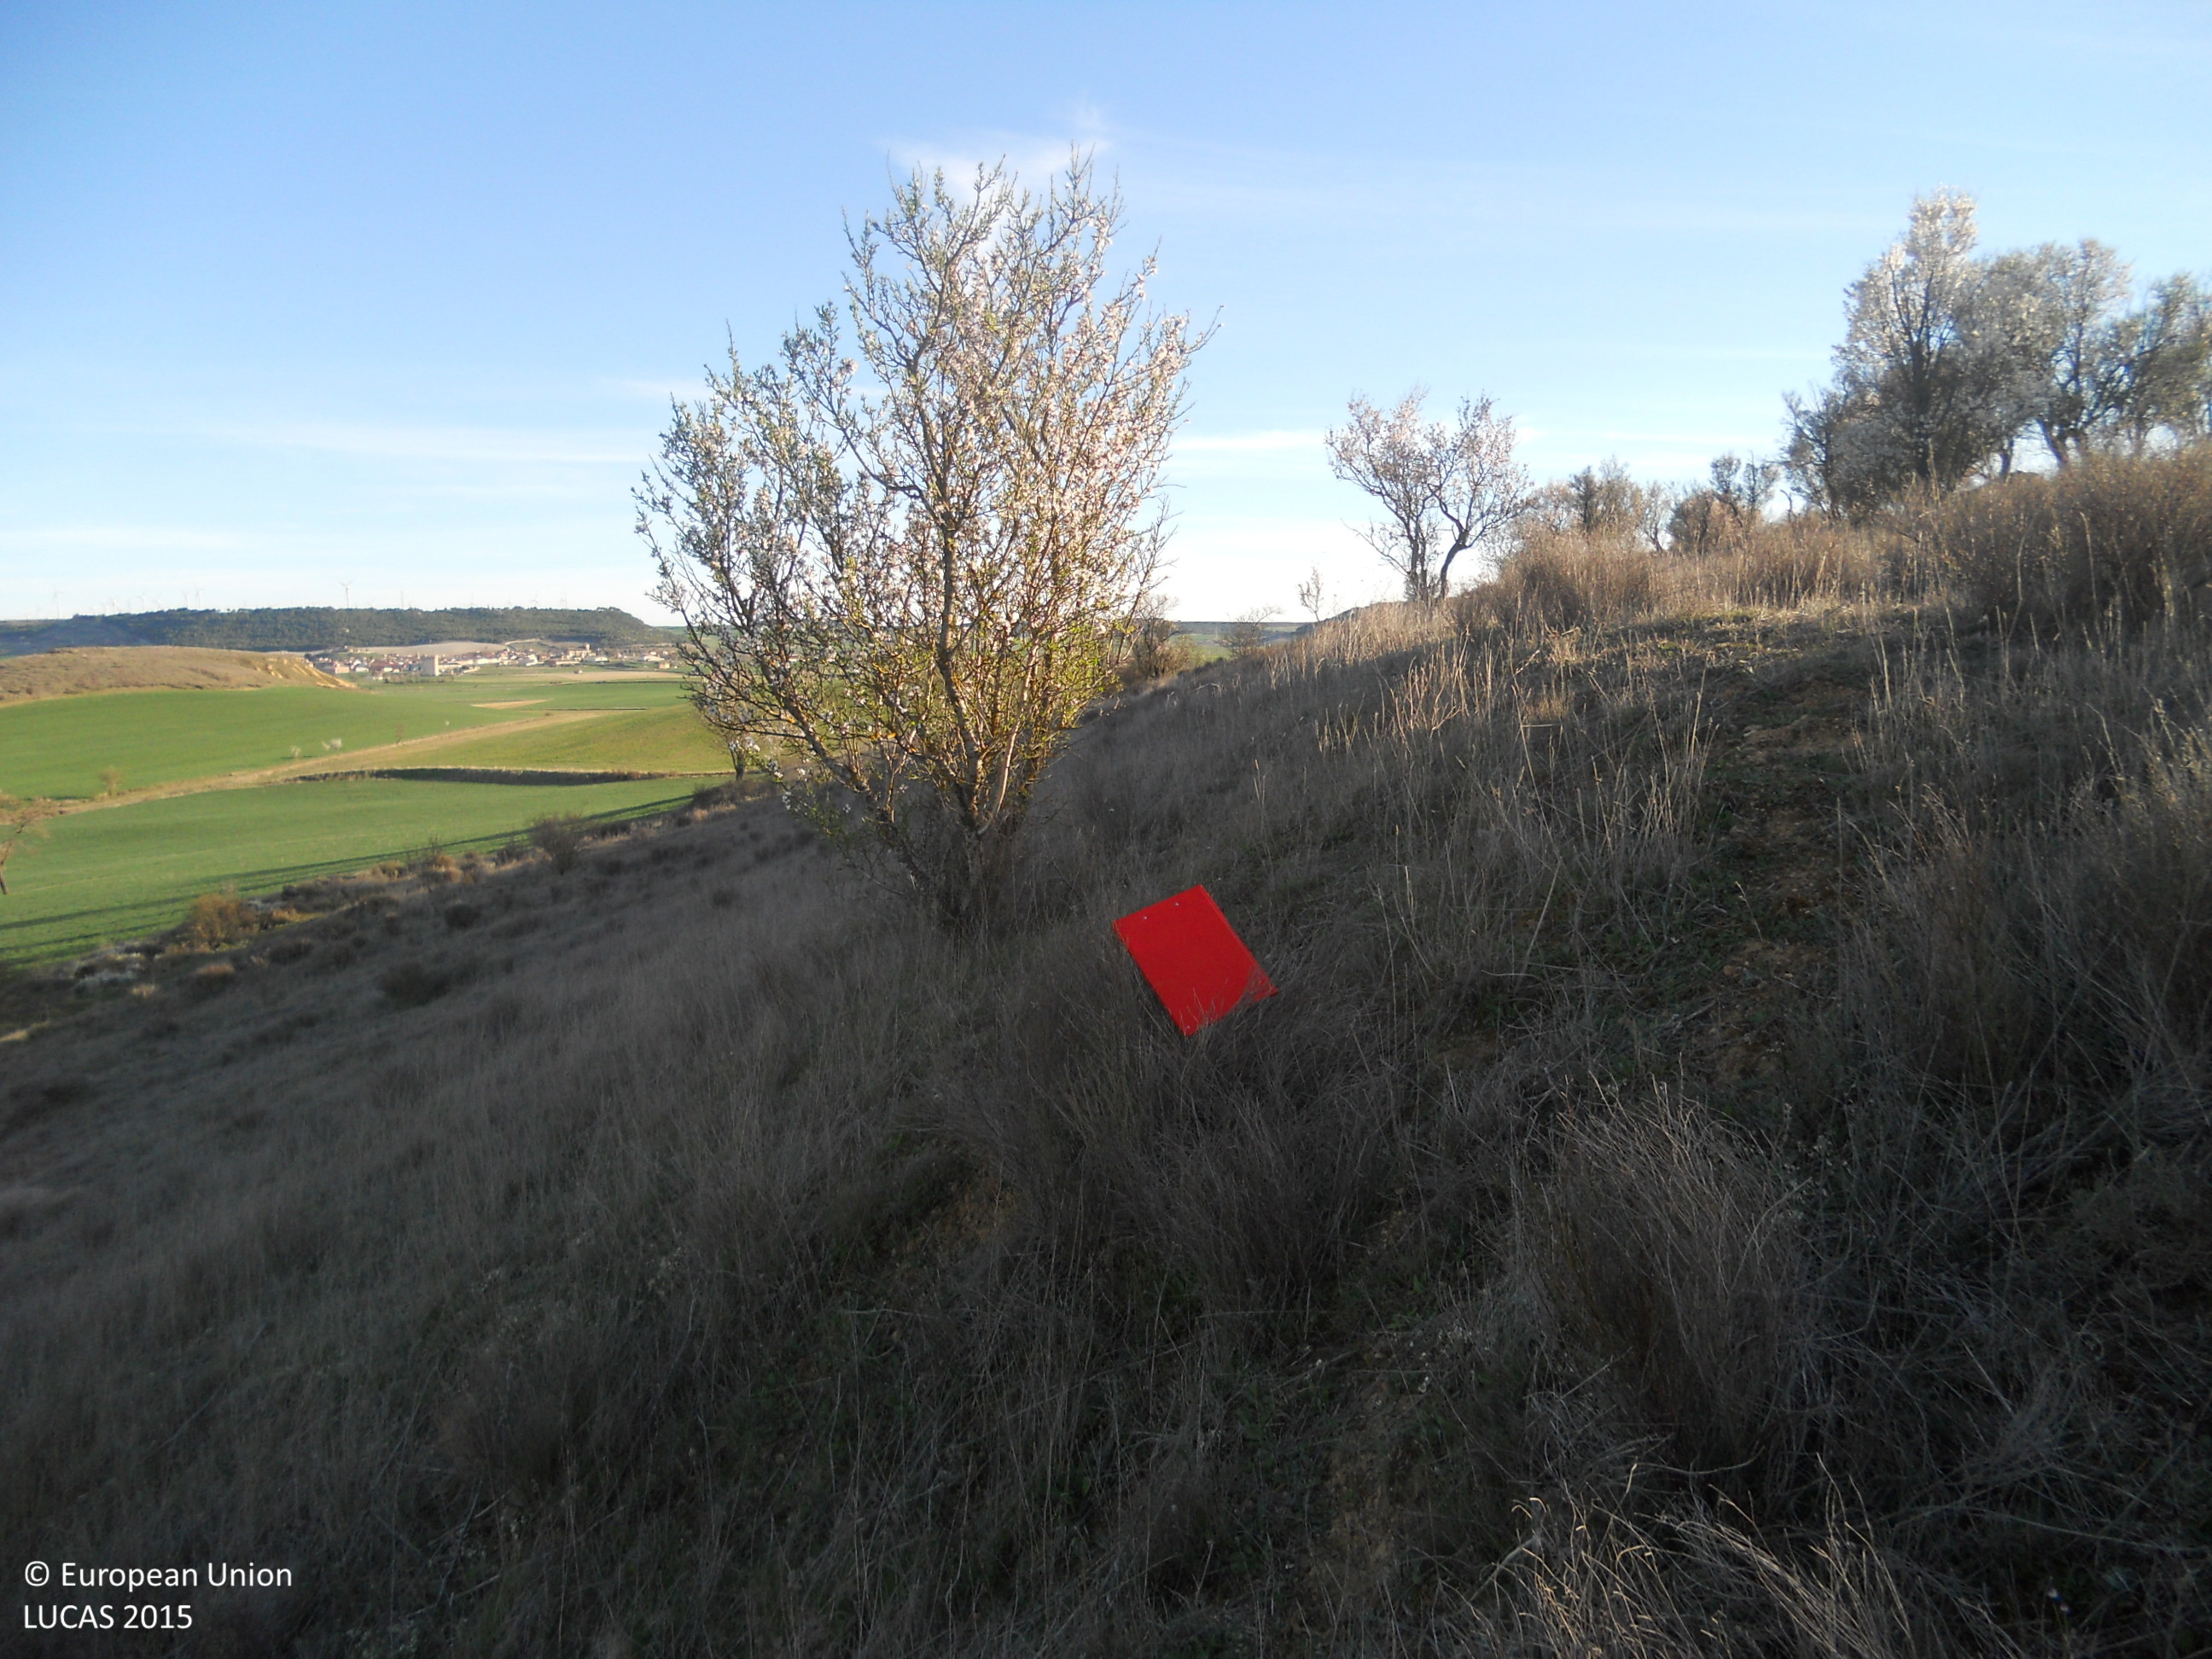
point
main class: Grassland
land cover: Grassland with sparse tree/shrub cover
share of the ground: > 75 %
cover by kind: herbaceous plants 90 %, broadleaved forest trees 5 %, lichens and mosses 5 %
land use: Semi-natural and natural areas not in use
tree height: < 5 m
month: April
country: ES
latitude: 42.2189
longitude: -4.3032
